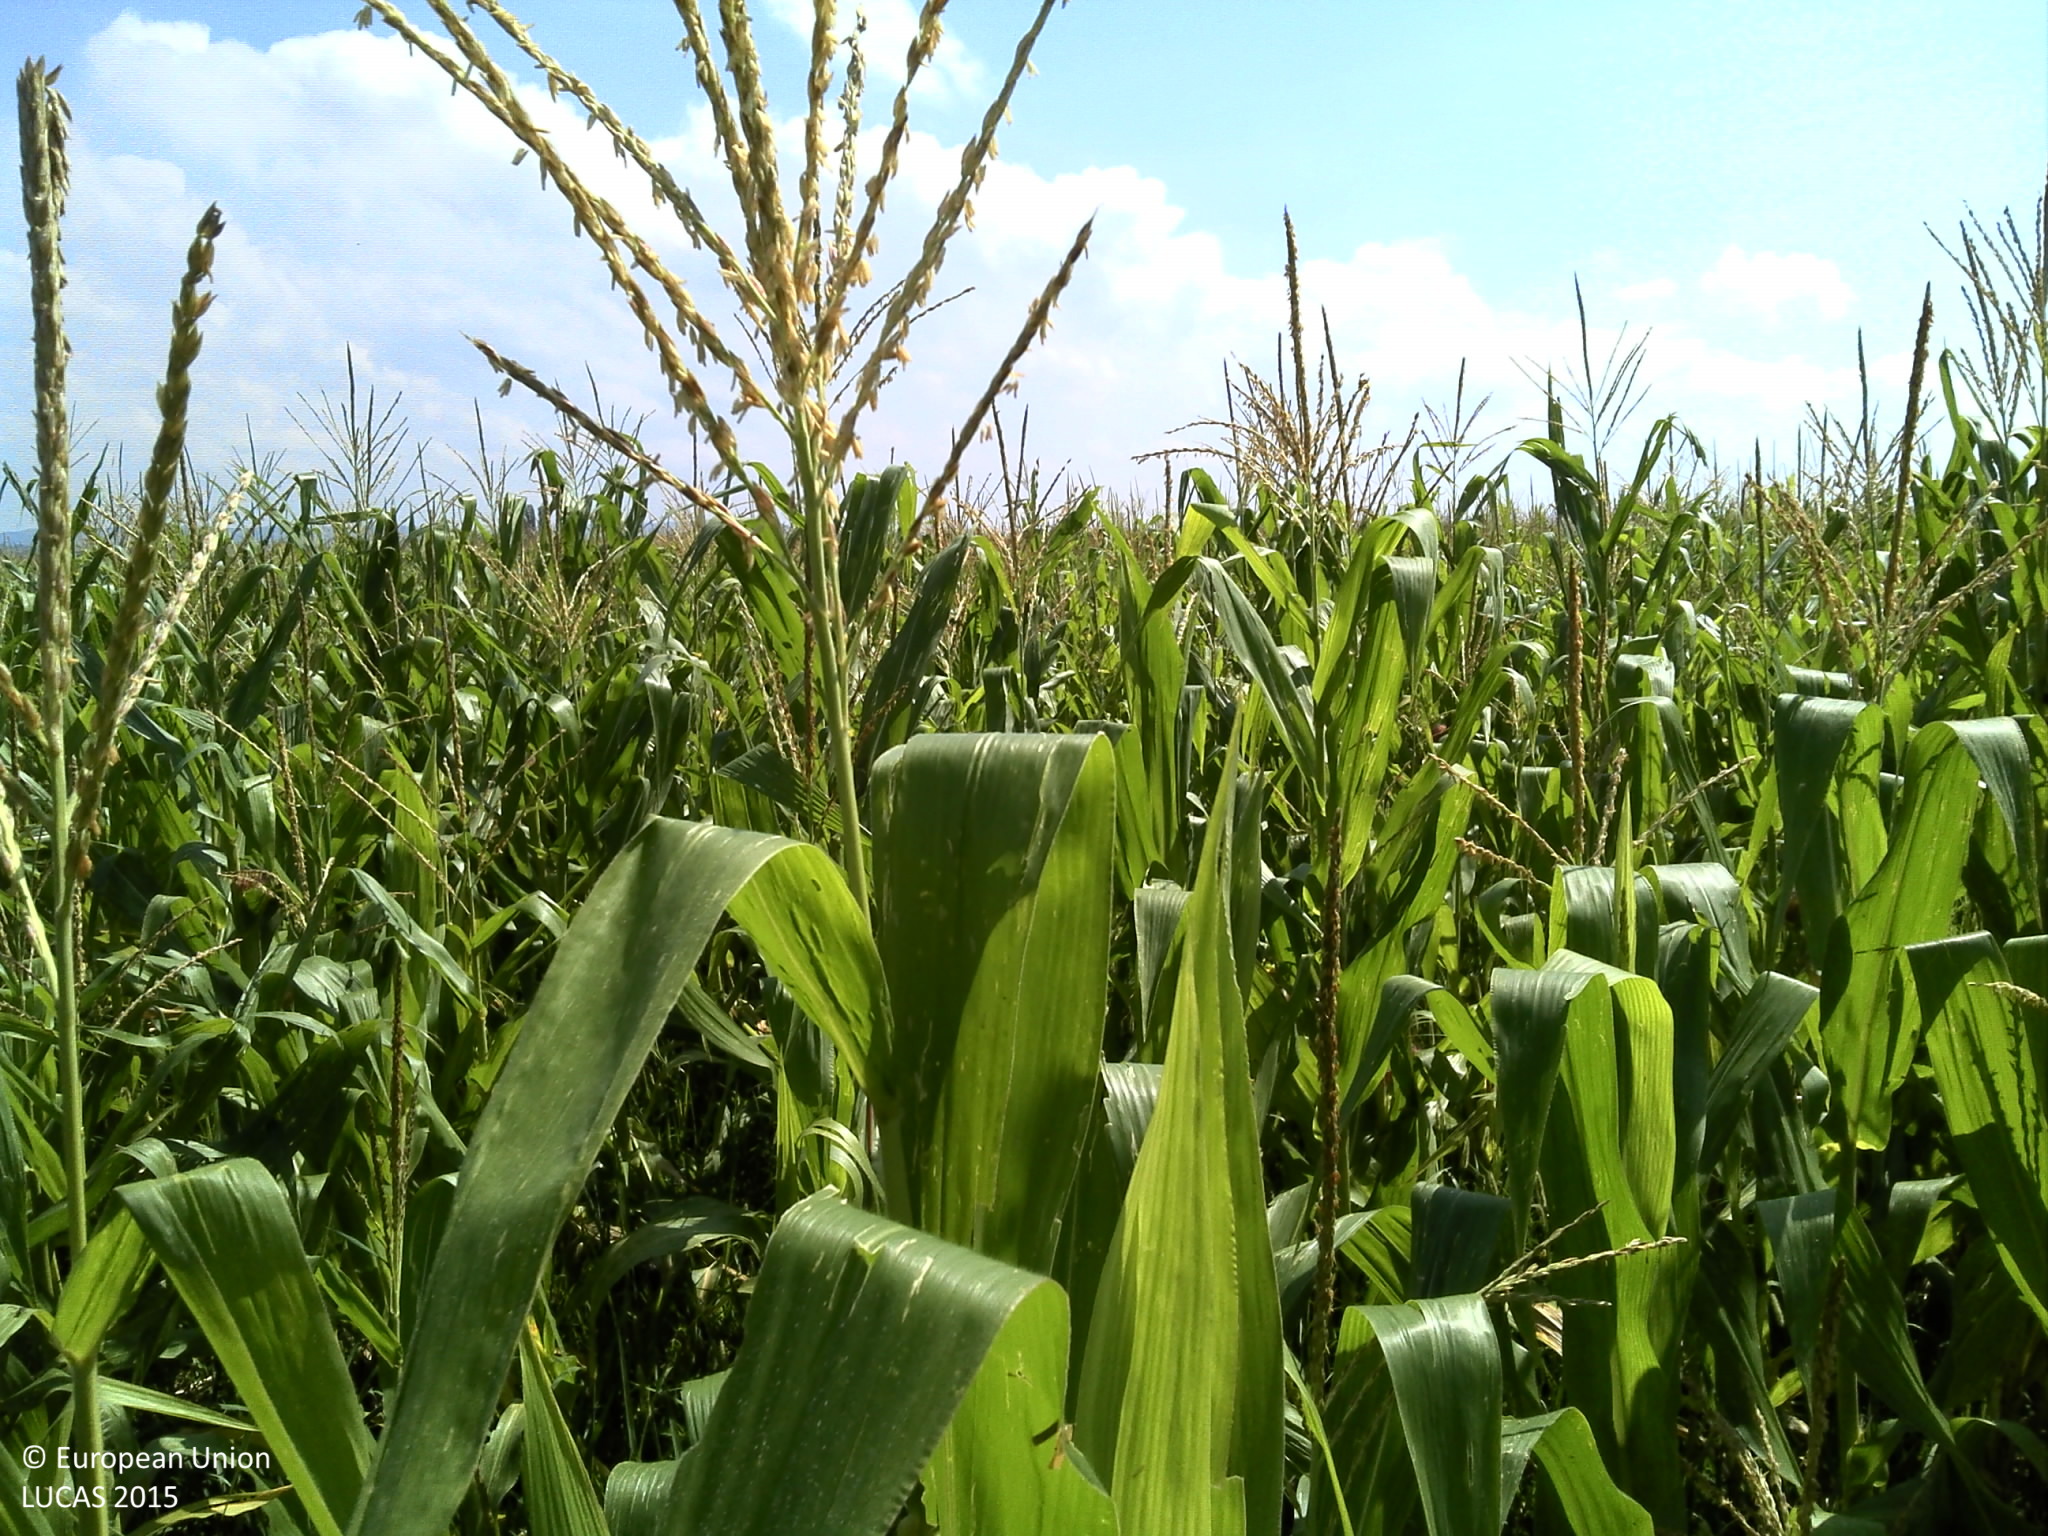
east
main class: Cropland
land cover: Maize
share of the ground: > 75 %
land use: Agriculture (excluding fallow land and kitchen gardens)
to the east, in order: Maize; Common wheat; Maize; Common wheat; Ditches and canals; Tracks; Oats; Grassland without tree/shrub cover
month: August
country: HR
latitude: 45.5528
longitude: 16.5699
